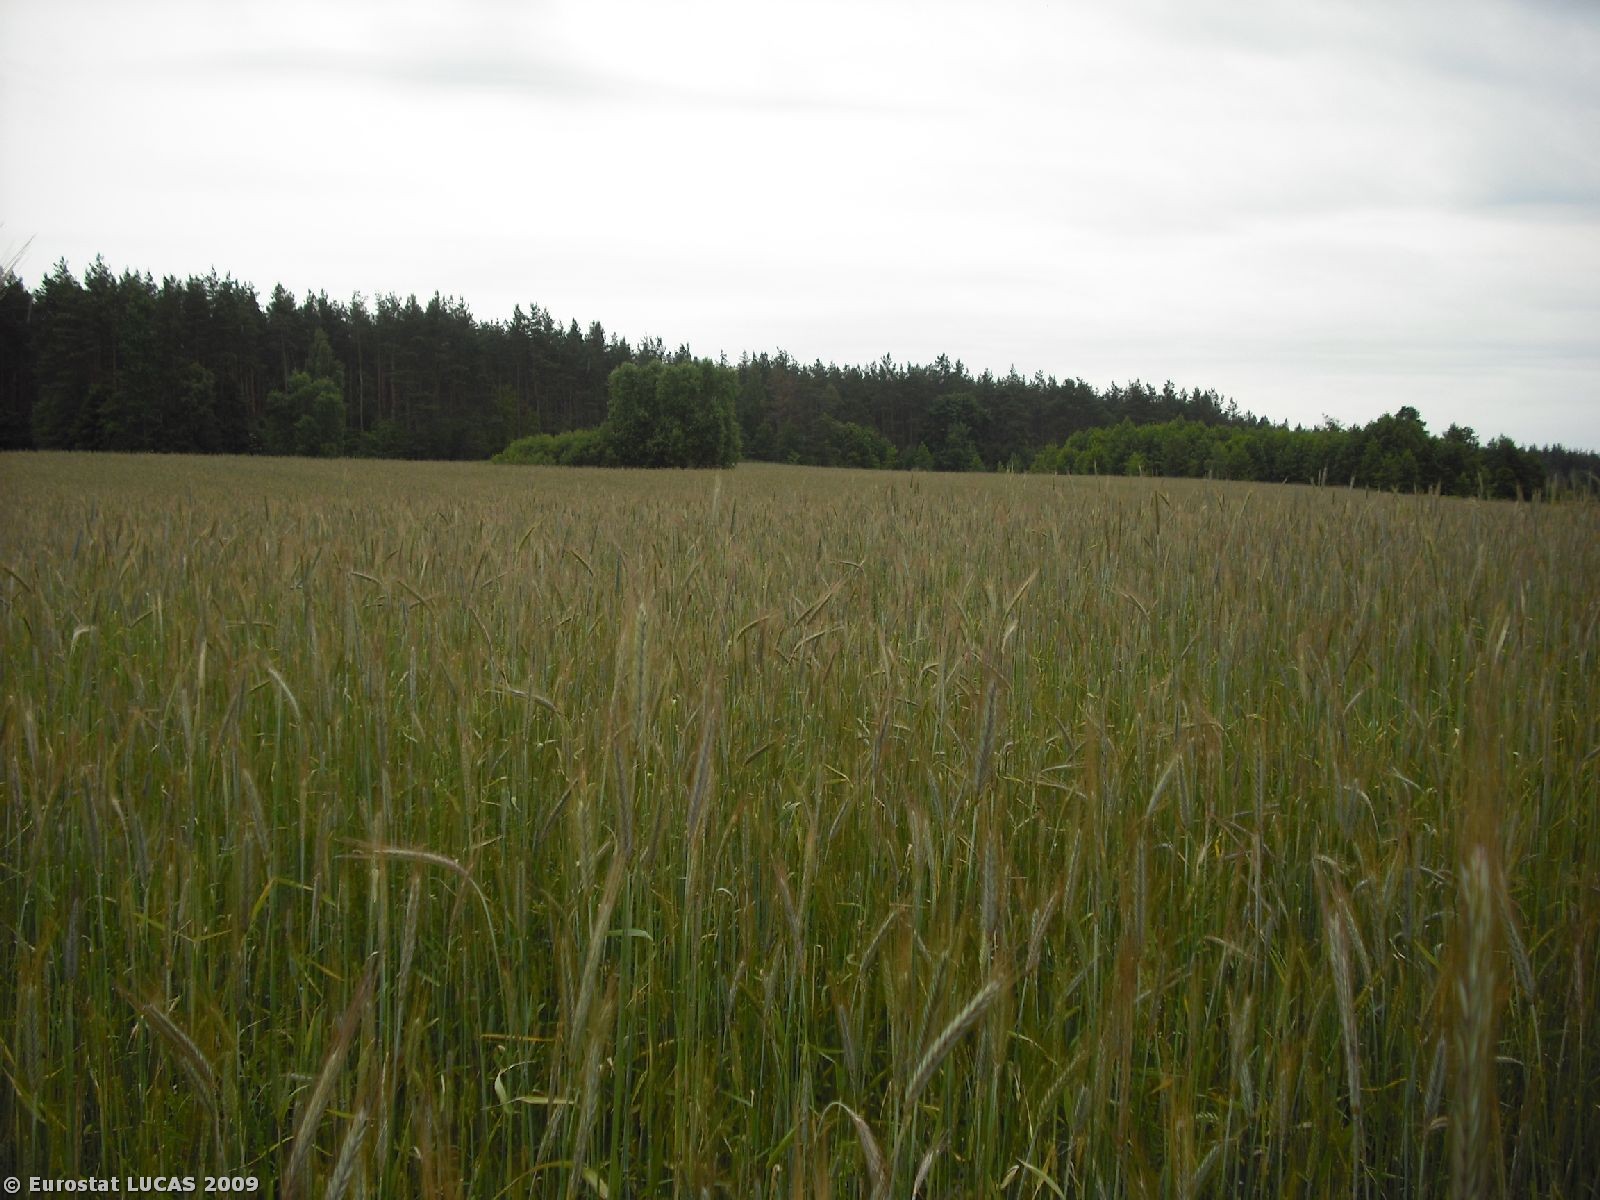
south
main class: Cropland
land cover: Rye
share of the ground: > 75 %
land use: Agriculture (excluding fallow land and kitchen gardens)
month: June
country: PL
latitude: 53.8337
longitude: 22.4172
